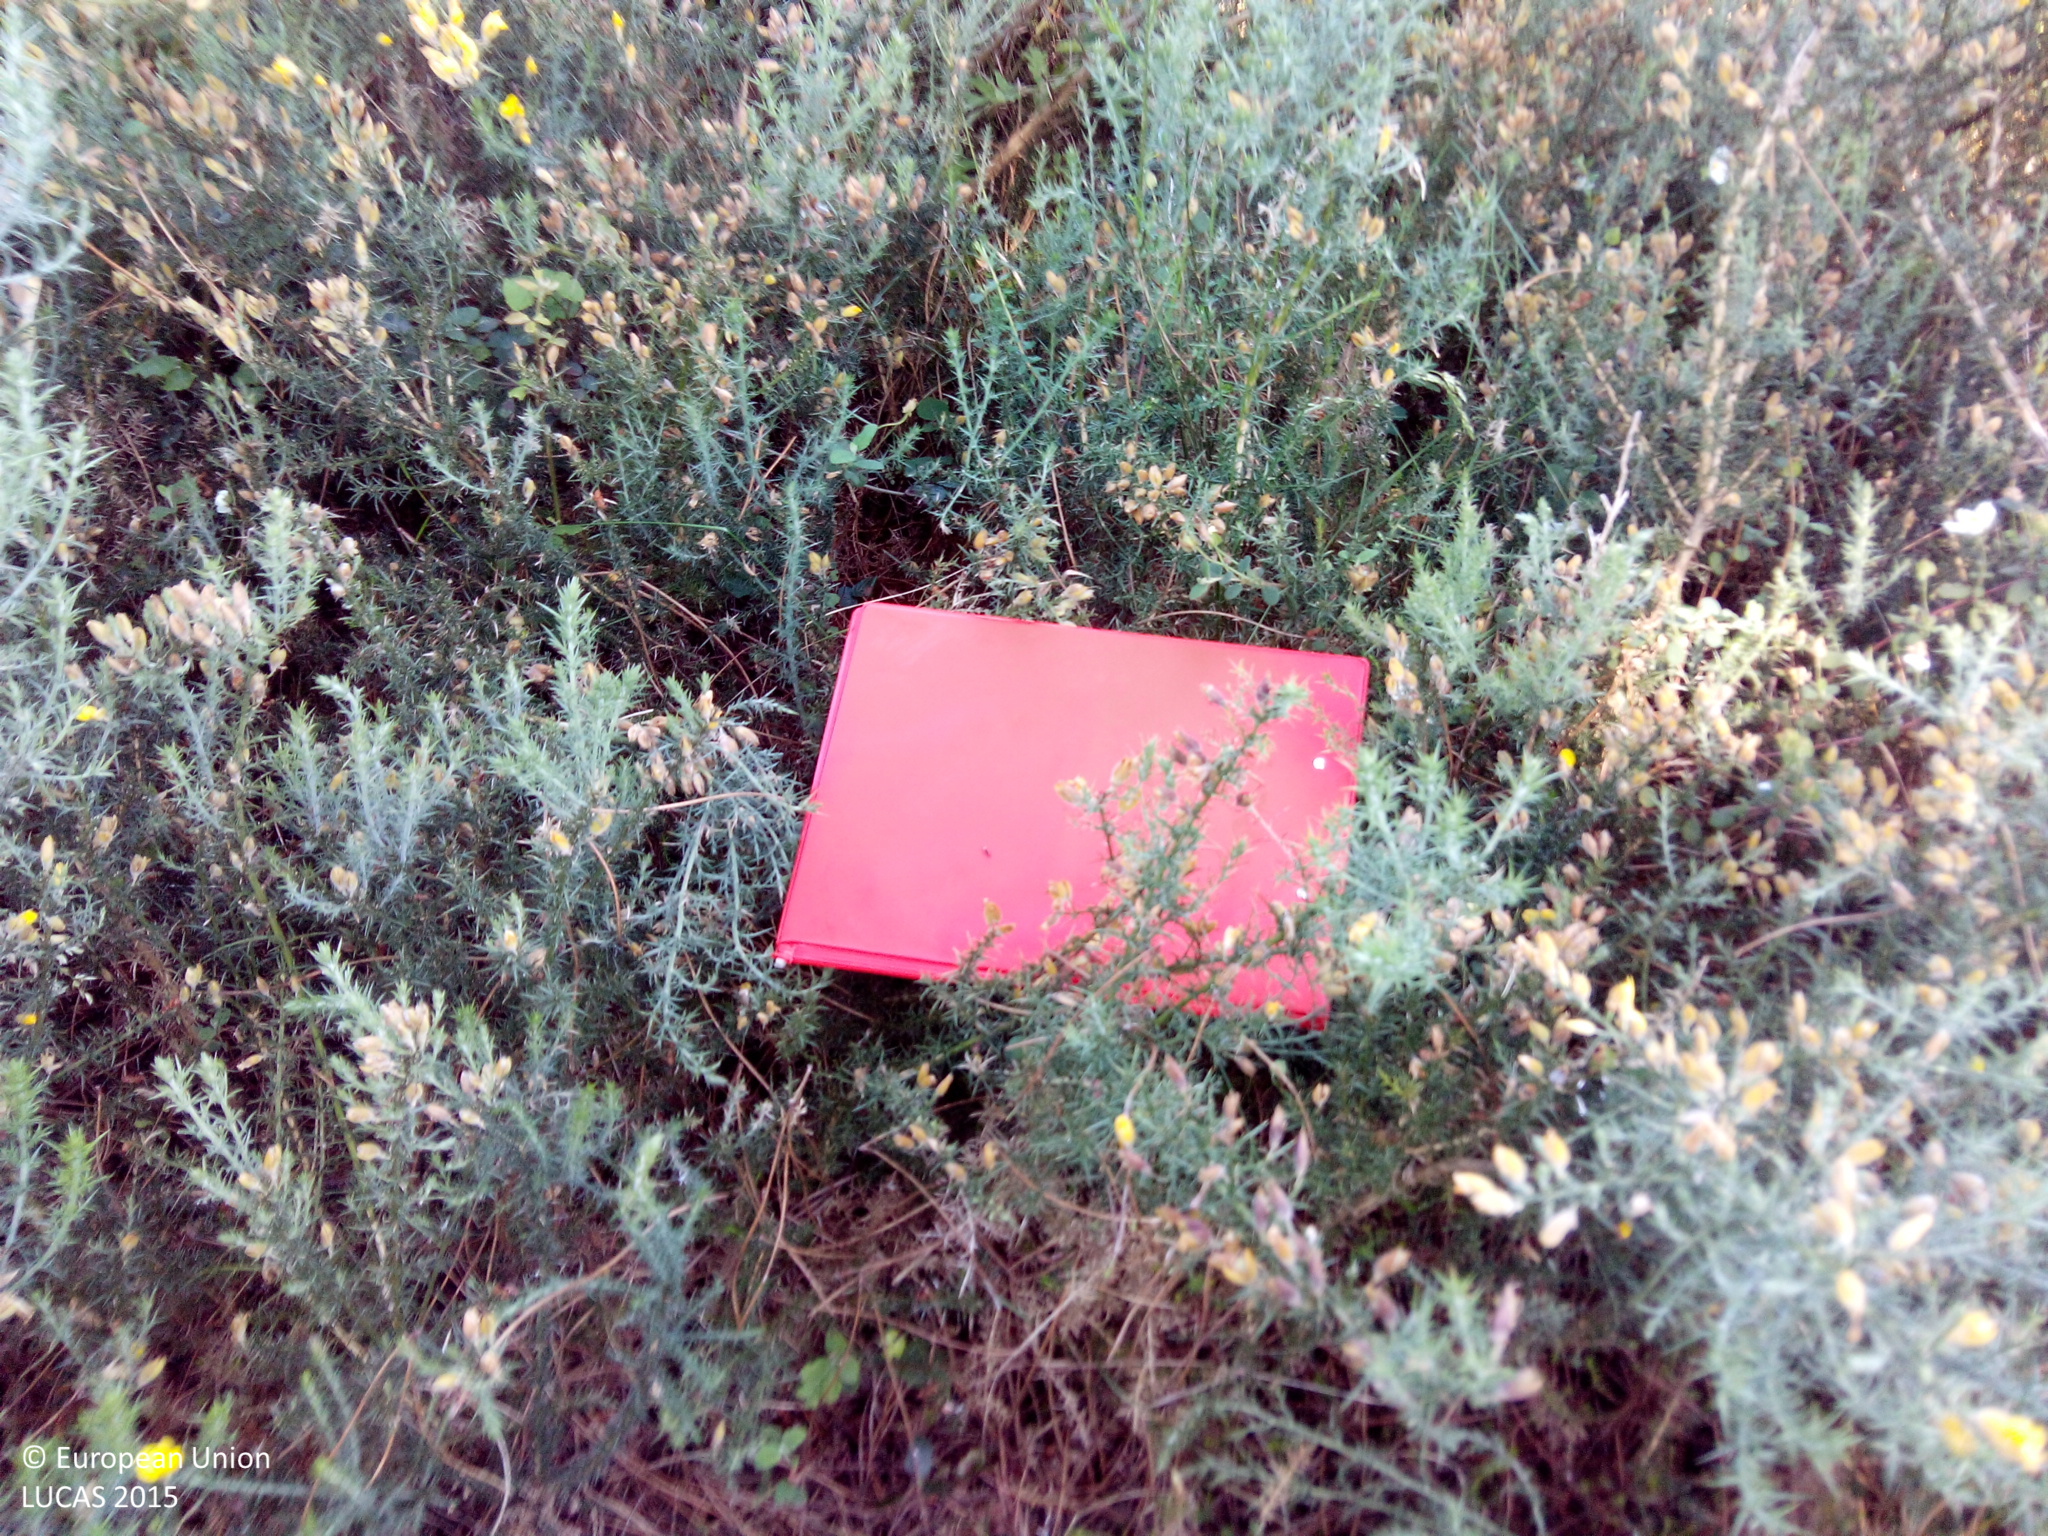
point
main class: Shrubland
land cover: Shrubland without tree cover
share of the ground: > 75 %
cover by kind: shrubs 100 %
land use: Semi-natural and natural areas not in use
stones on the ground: < 10 %
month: May
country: ES
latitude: 42.5555
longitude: -9.0051
